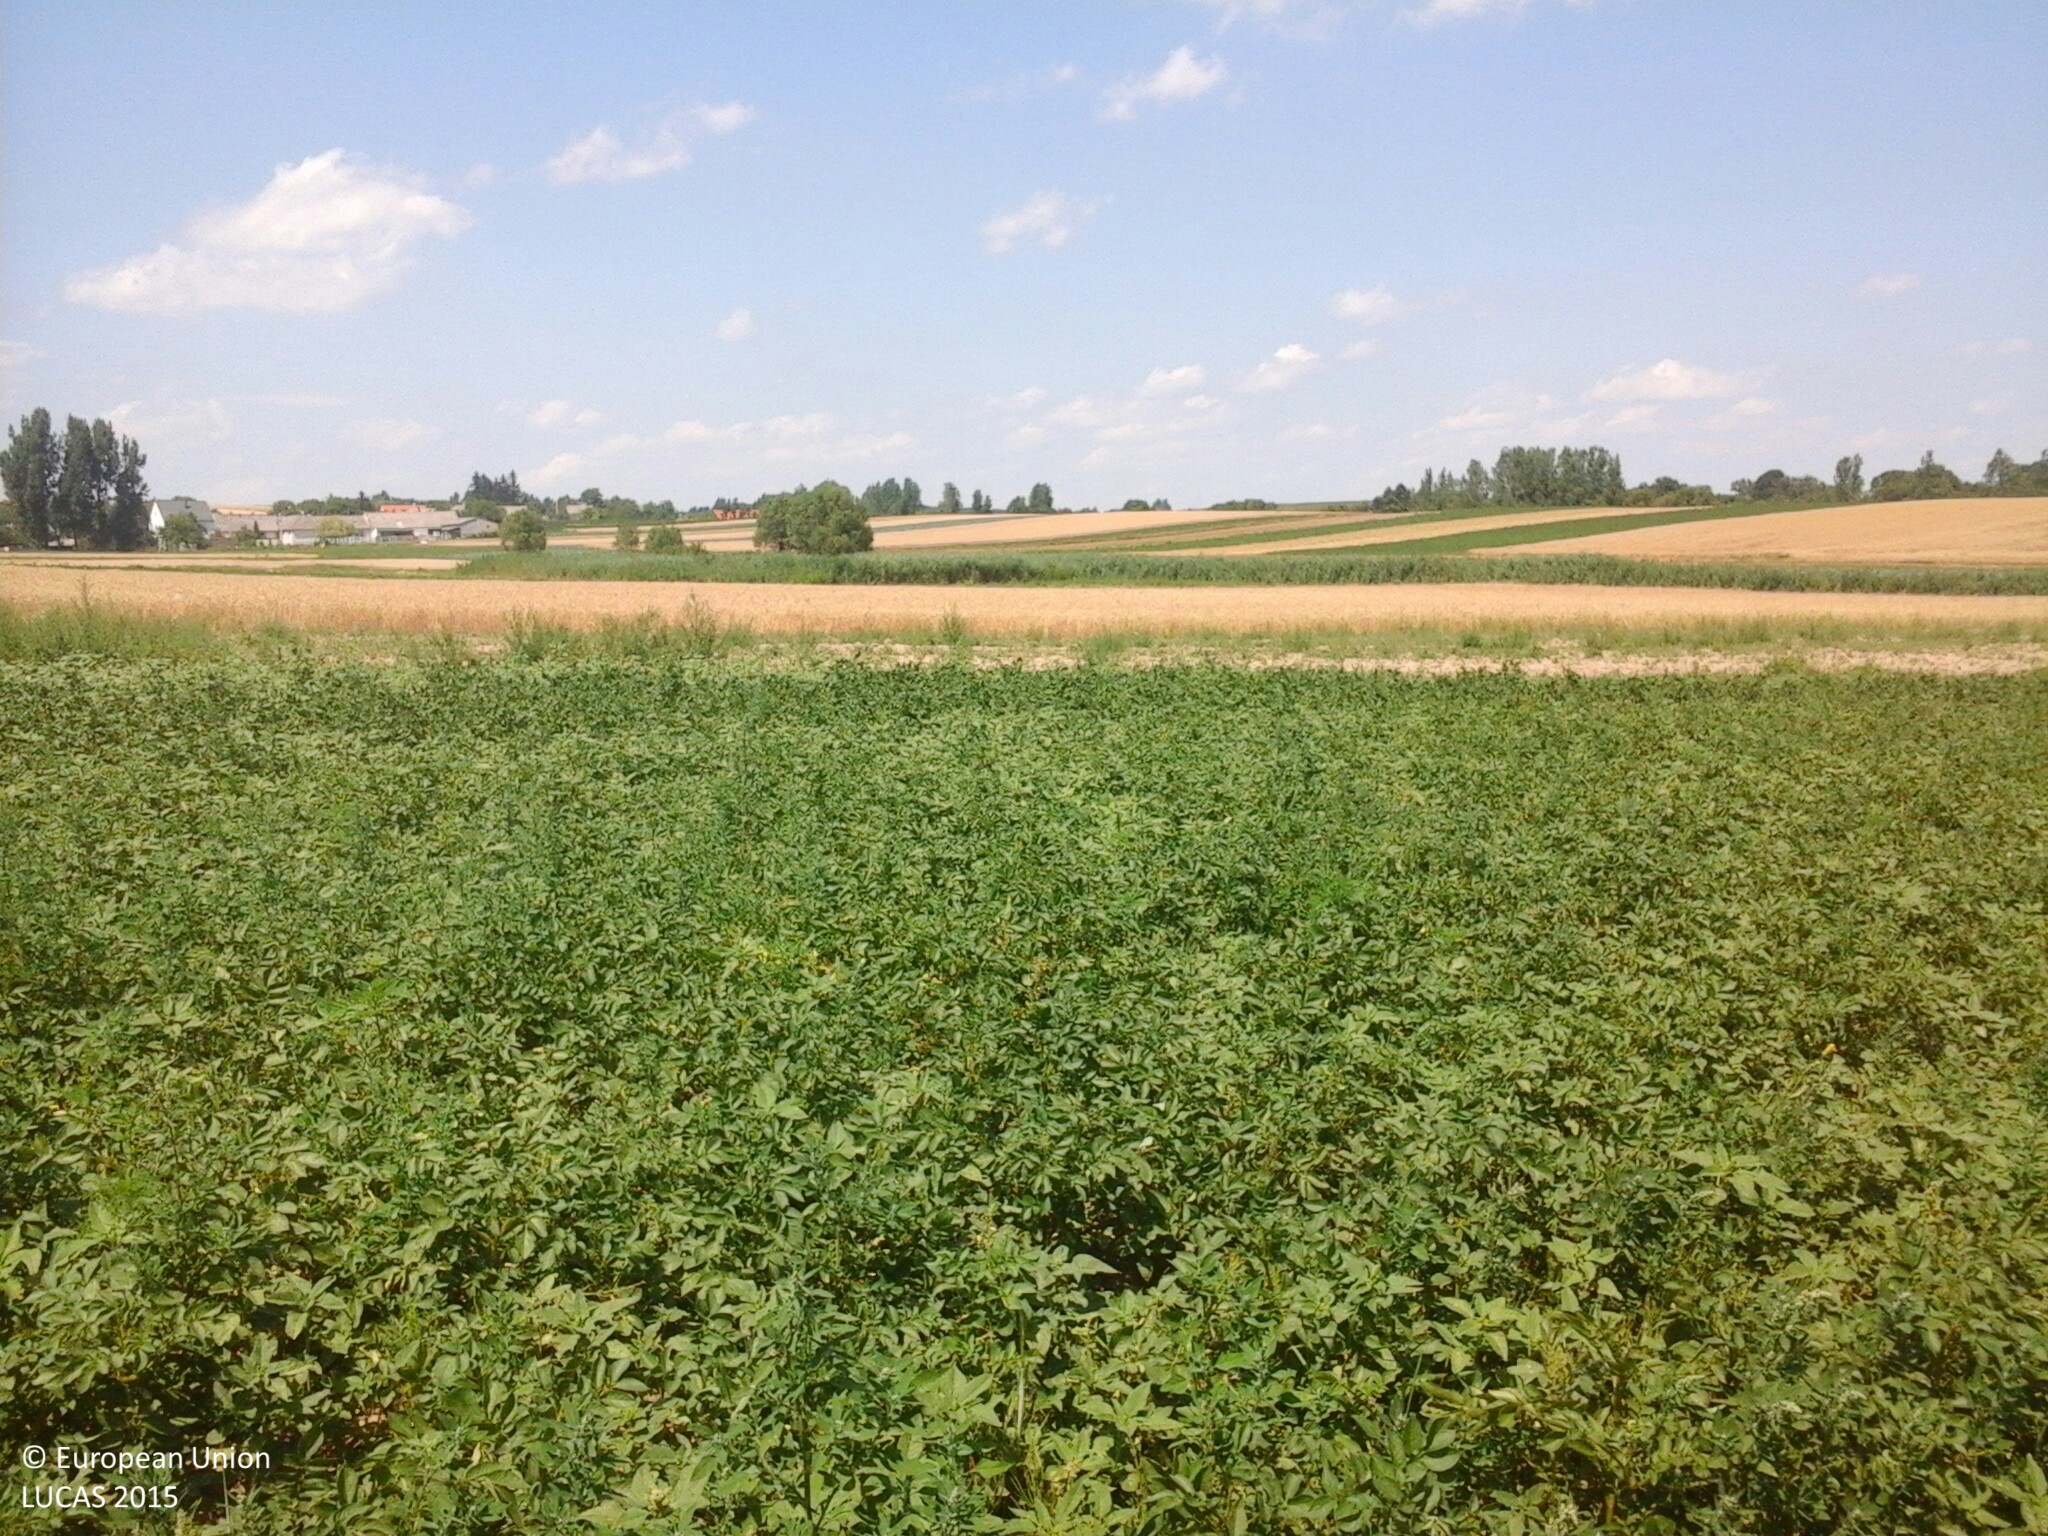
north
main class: Cropland
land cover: Potatoes
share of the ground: > 75 %
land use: Agriculture (excluding fallow land and kitchen gardens)
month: July
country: HU
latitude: 47.2330
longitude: 17.9214
